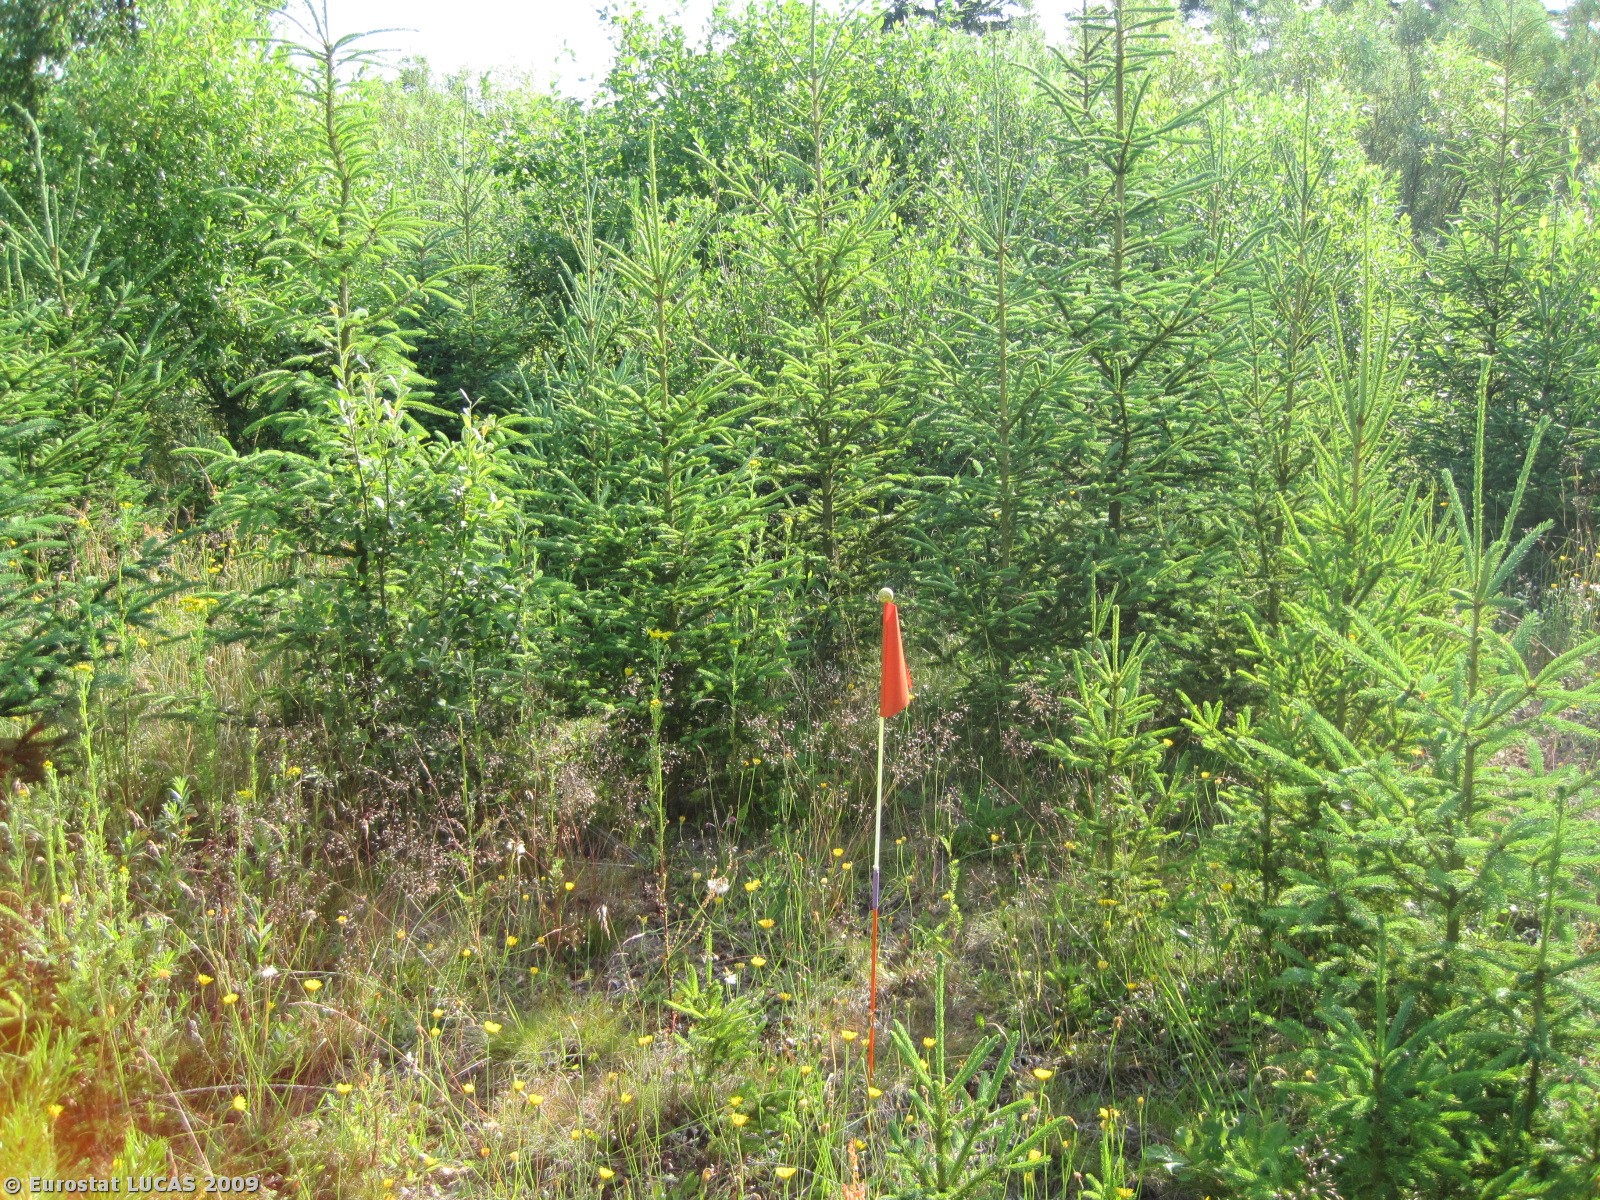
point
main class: Woodland
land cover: Mixed woodland
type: plantations and self-sown exotic forest
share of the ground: 25 - 50 %
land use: Forestry
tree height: > 5 m
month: July
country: DK
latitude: 56.4873
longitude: 8.7511
